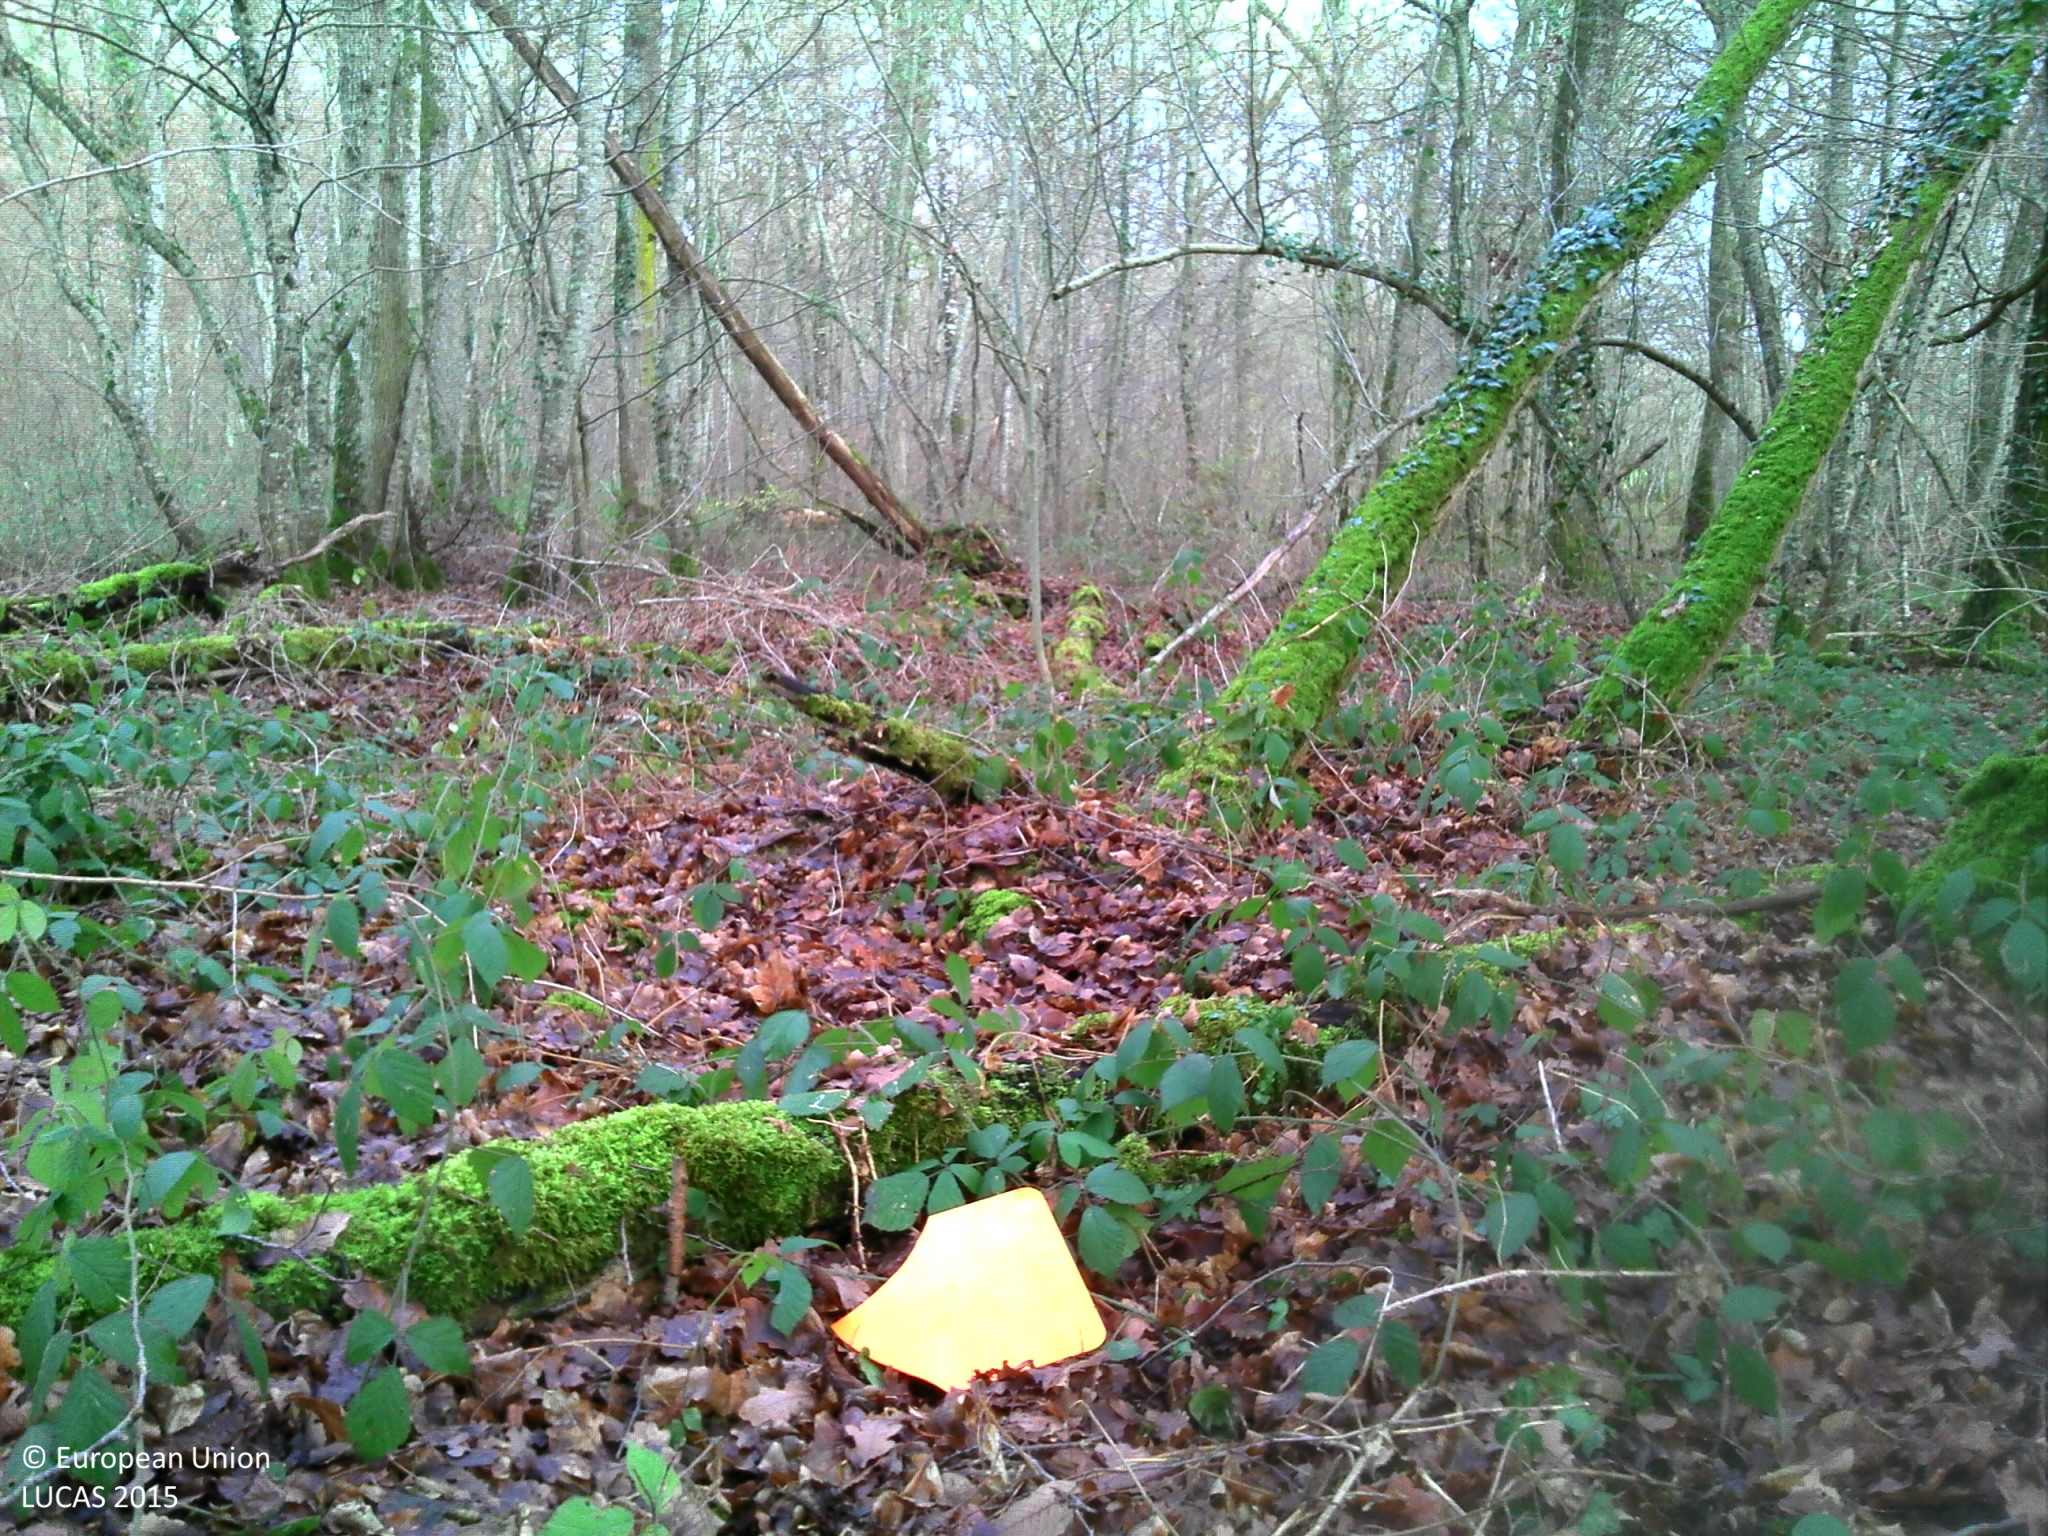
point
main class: Woodland
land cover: Broadleaved woodland
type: mesophytic deciduous forest
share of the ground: > 75 %
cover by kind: broadleaved forest trees 100 %
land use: Forestry
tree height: > 5 m
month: December
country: FR
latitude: 47.2621
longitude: 3.6140
